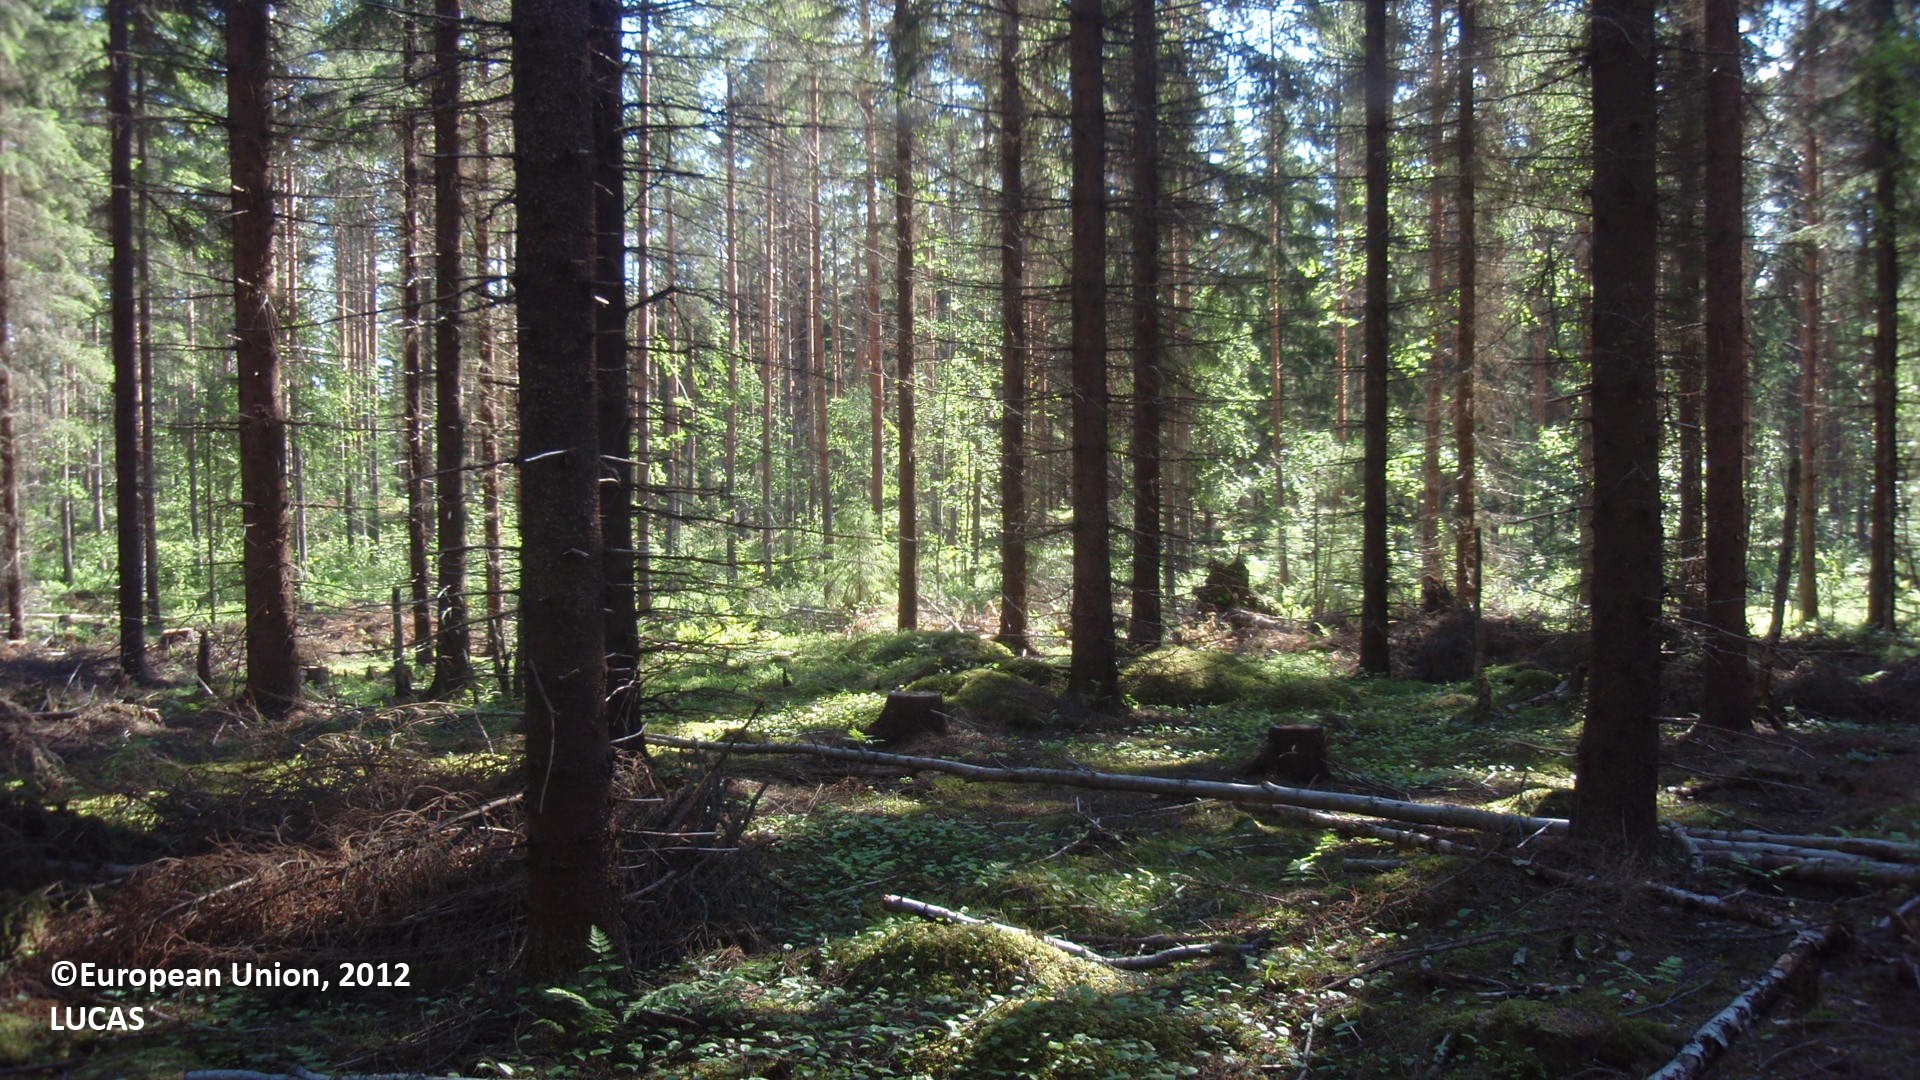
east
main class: Woodland
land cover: Spruce dominated coniferous woodland
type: boreal forest
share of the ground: 50 - 75 %
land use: Forestry
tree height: > 5 m
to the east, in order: Spruce dominated coniferous woodland; Pine dominated coniferous woodland; Ditches and canals; Pine dominated coniferous woodland; Spruce dominated mixed woodland; Ditches and canals; Broadleaved woodland; Ditches and canals; Broadleaved woodland; Shrubland with sparse tree cover; Electric lines; Shrubland with sparse tree cover; Electric lines; Shrubland with sparse tree cover; Other mixed woodland
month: June
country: FI
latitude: 61.3978
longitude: 26.8040
